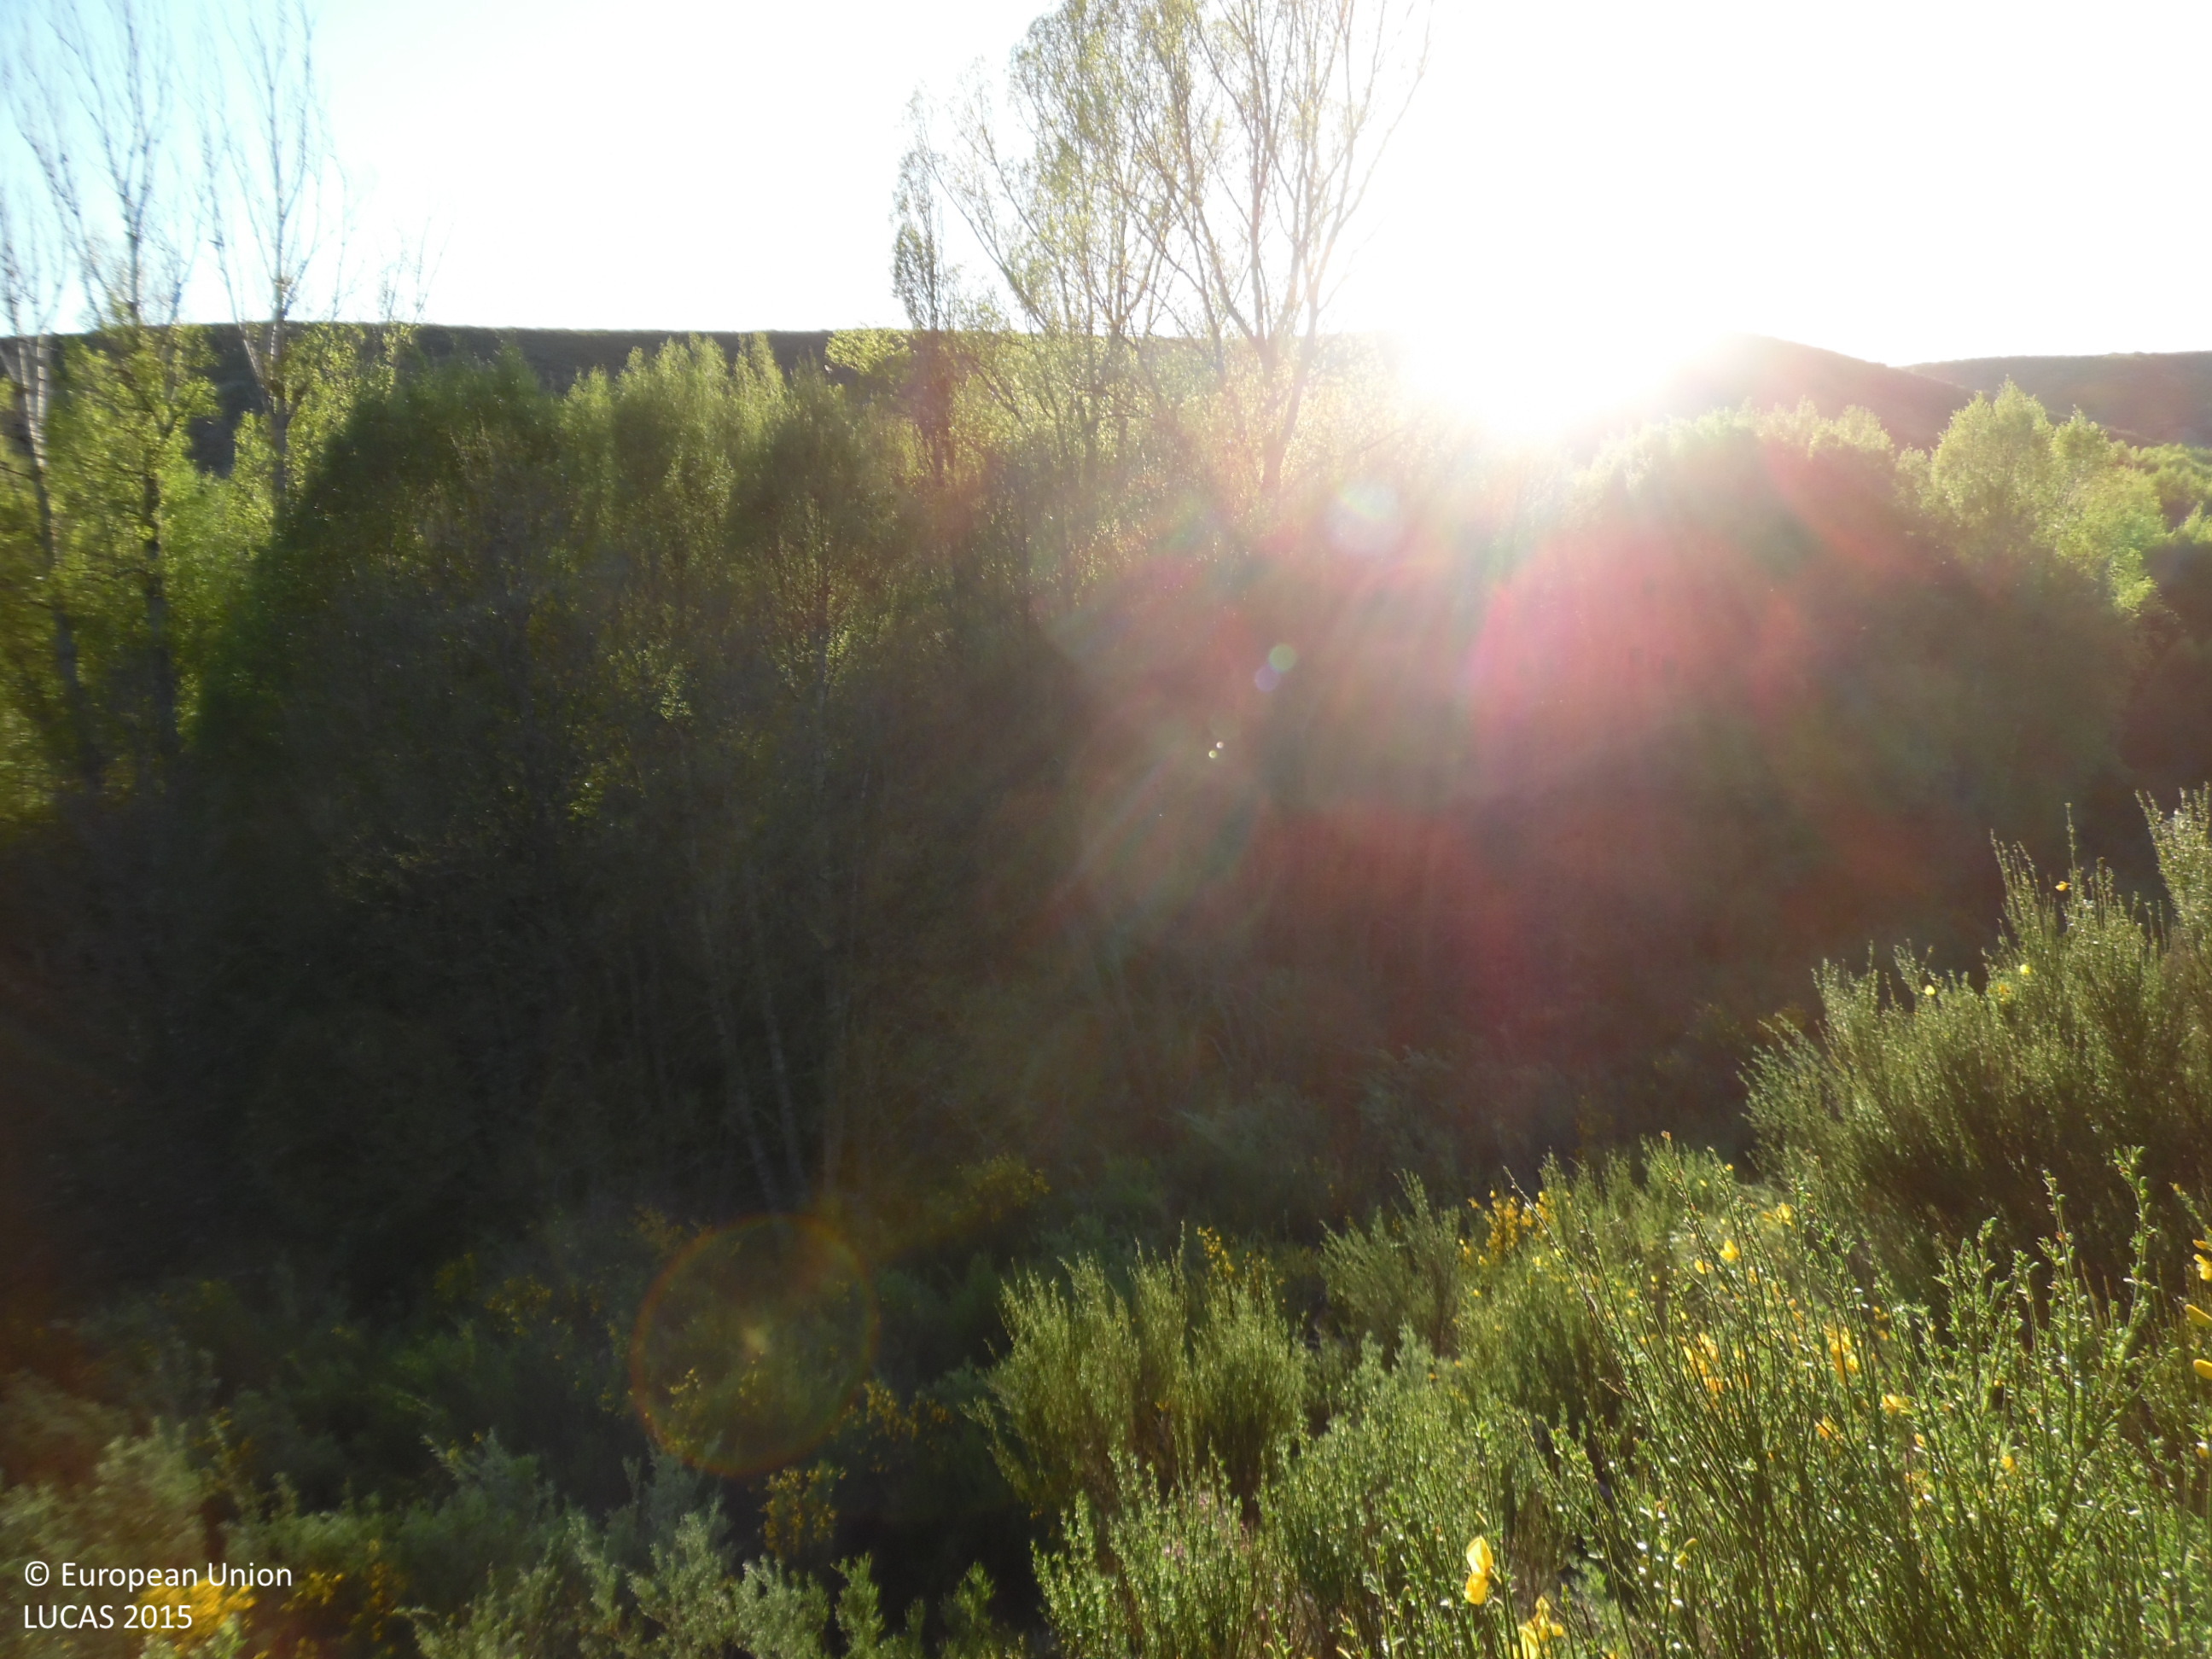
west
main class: Shrubland
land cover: Shrubland without tree cover
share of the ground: > 75 %
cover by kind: shrubs 100 %
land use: Semi-natural and natural areas not in use
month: May
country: ES
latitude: 42.6779
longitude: -6.1082
